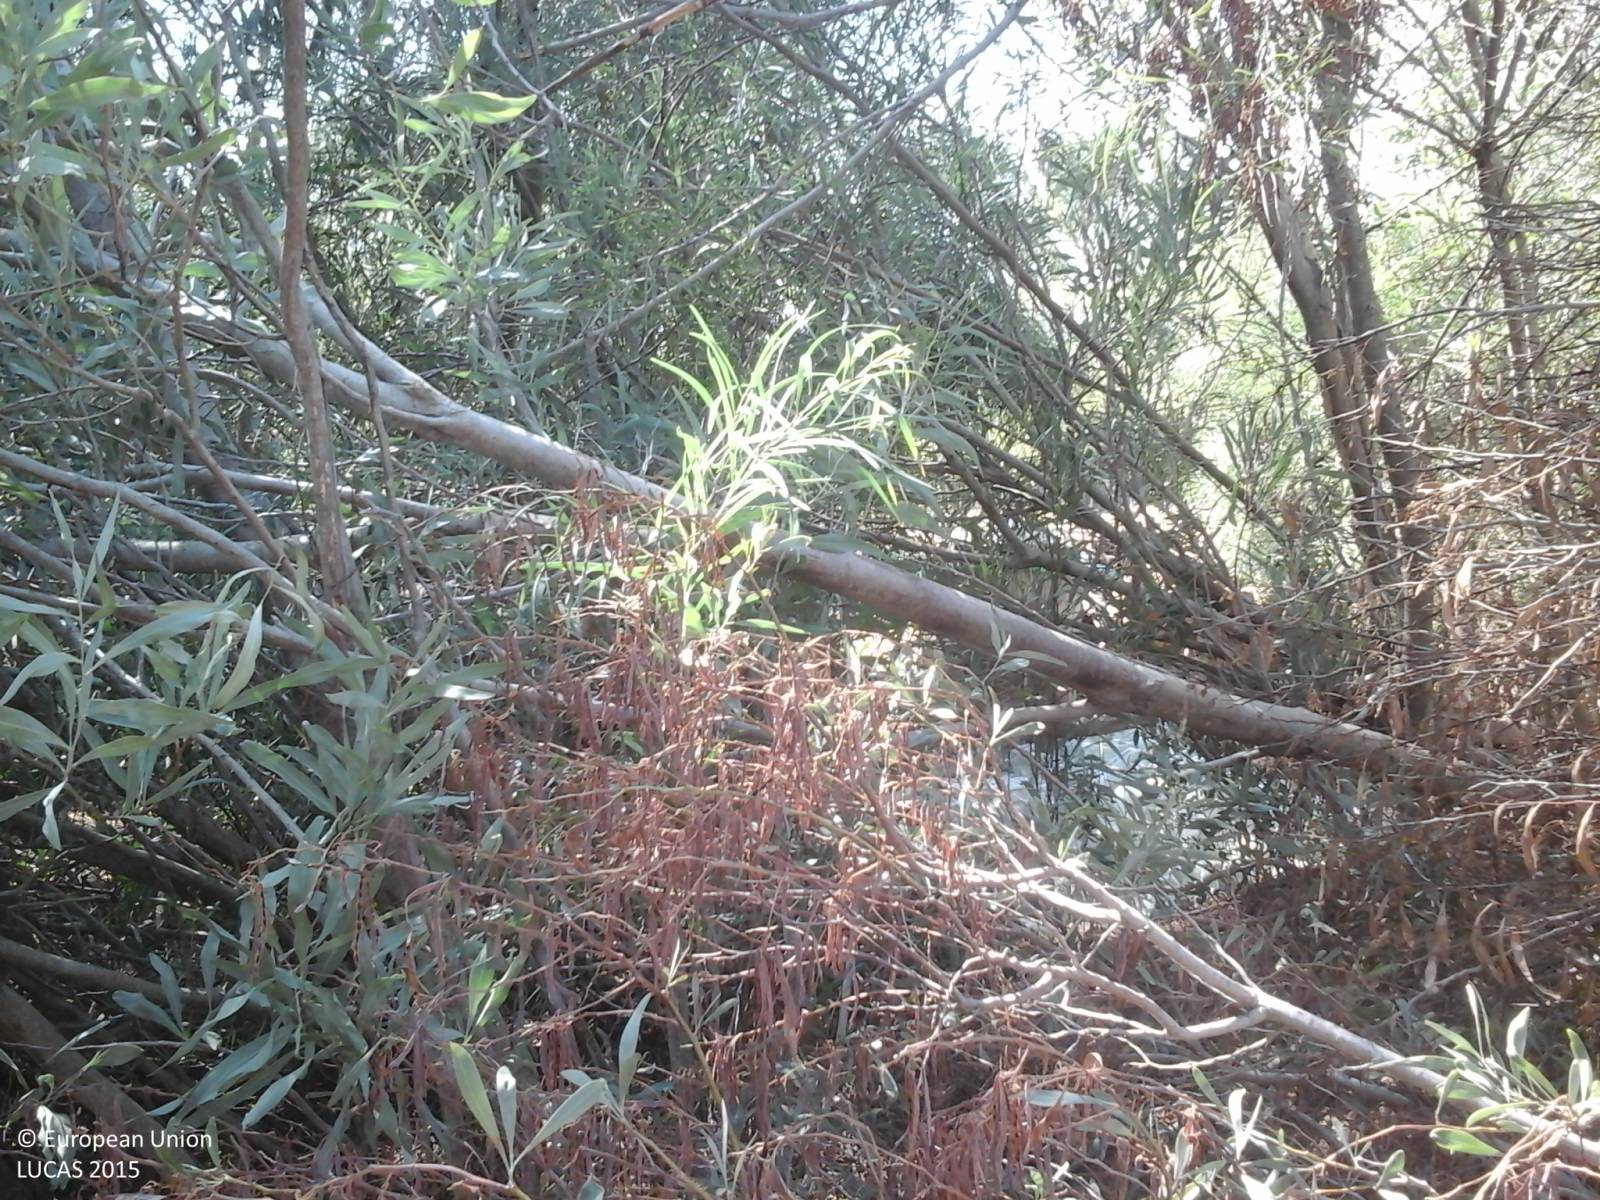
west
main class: Woodland
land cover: Broadleaved woodland
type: broadleaved evergreen forest
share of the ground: > 75 %
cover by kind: broadleaved forest trees 90 %, shrubs 5 %, herbaceous plants 5 %
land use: Residential
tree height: > 5 m
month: September
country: IT
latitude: 41.1878
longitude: 9.3235
